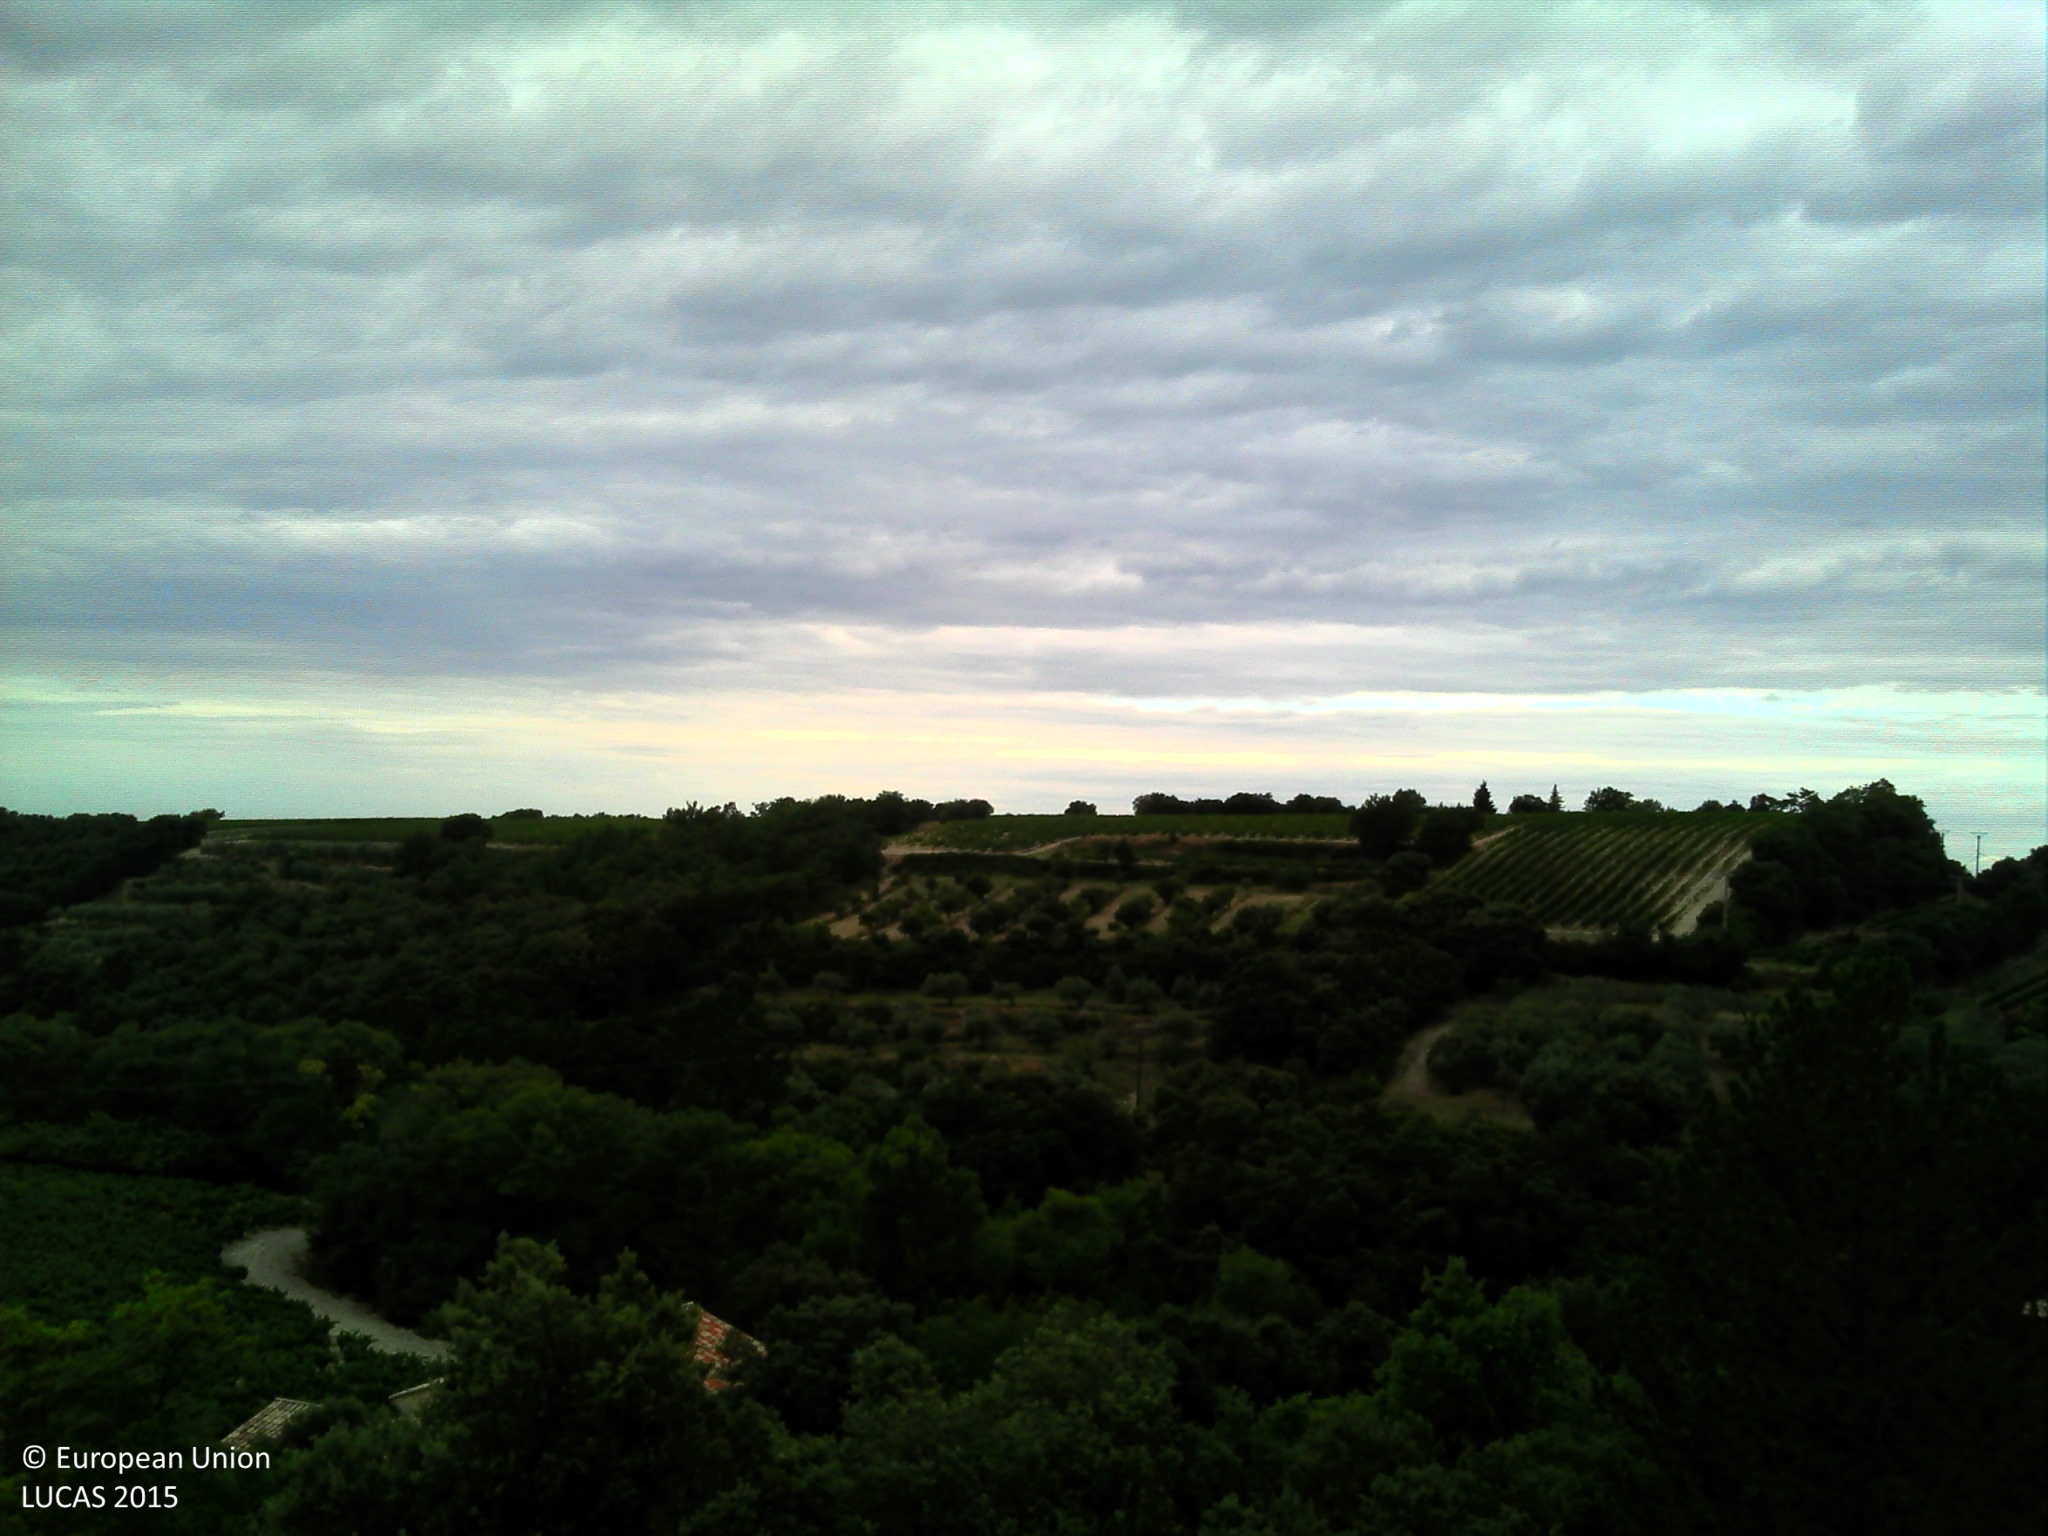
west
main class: Shrubland
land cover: Shrubland with sparse tree cover
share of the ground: > 75 %
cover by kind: shrubs 95 %, coniferous forest trees 5 %
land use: Semi-natural and natural areas not in use
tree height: < 5 m
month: September
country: FR
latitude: 44.4141
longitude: 5.0717
